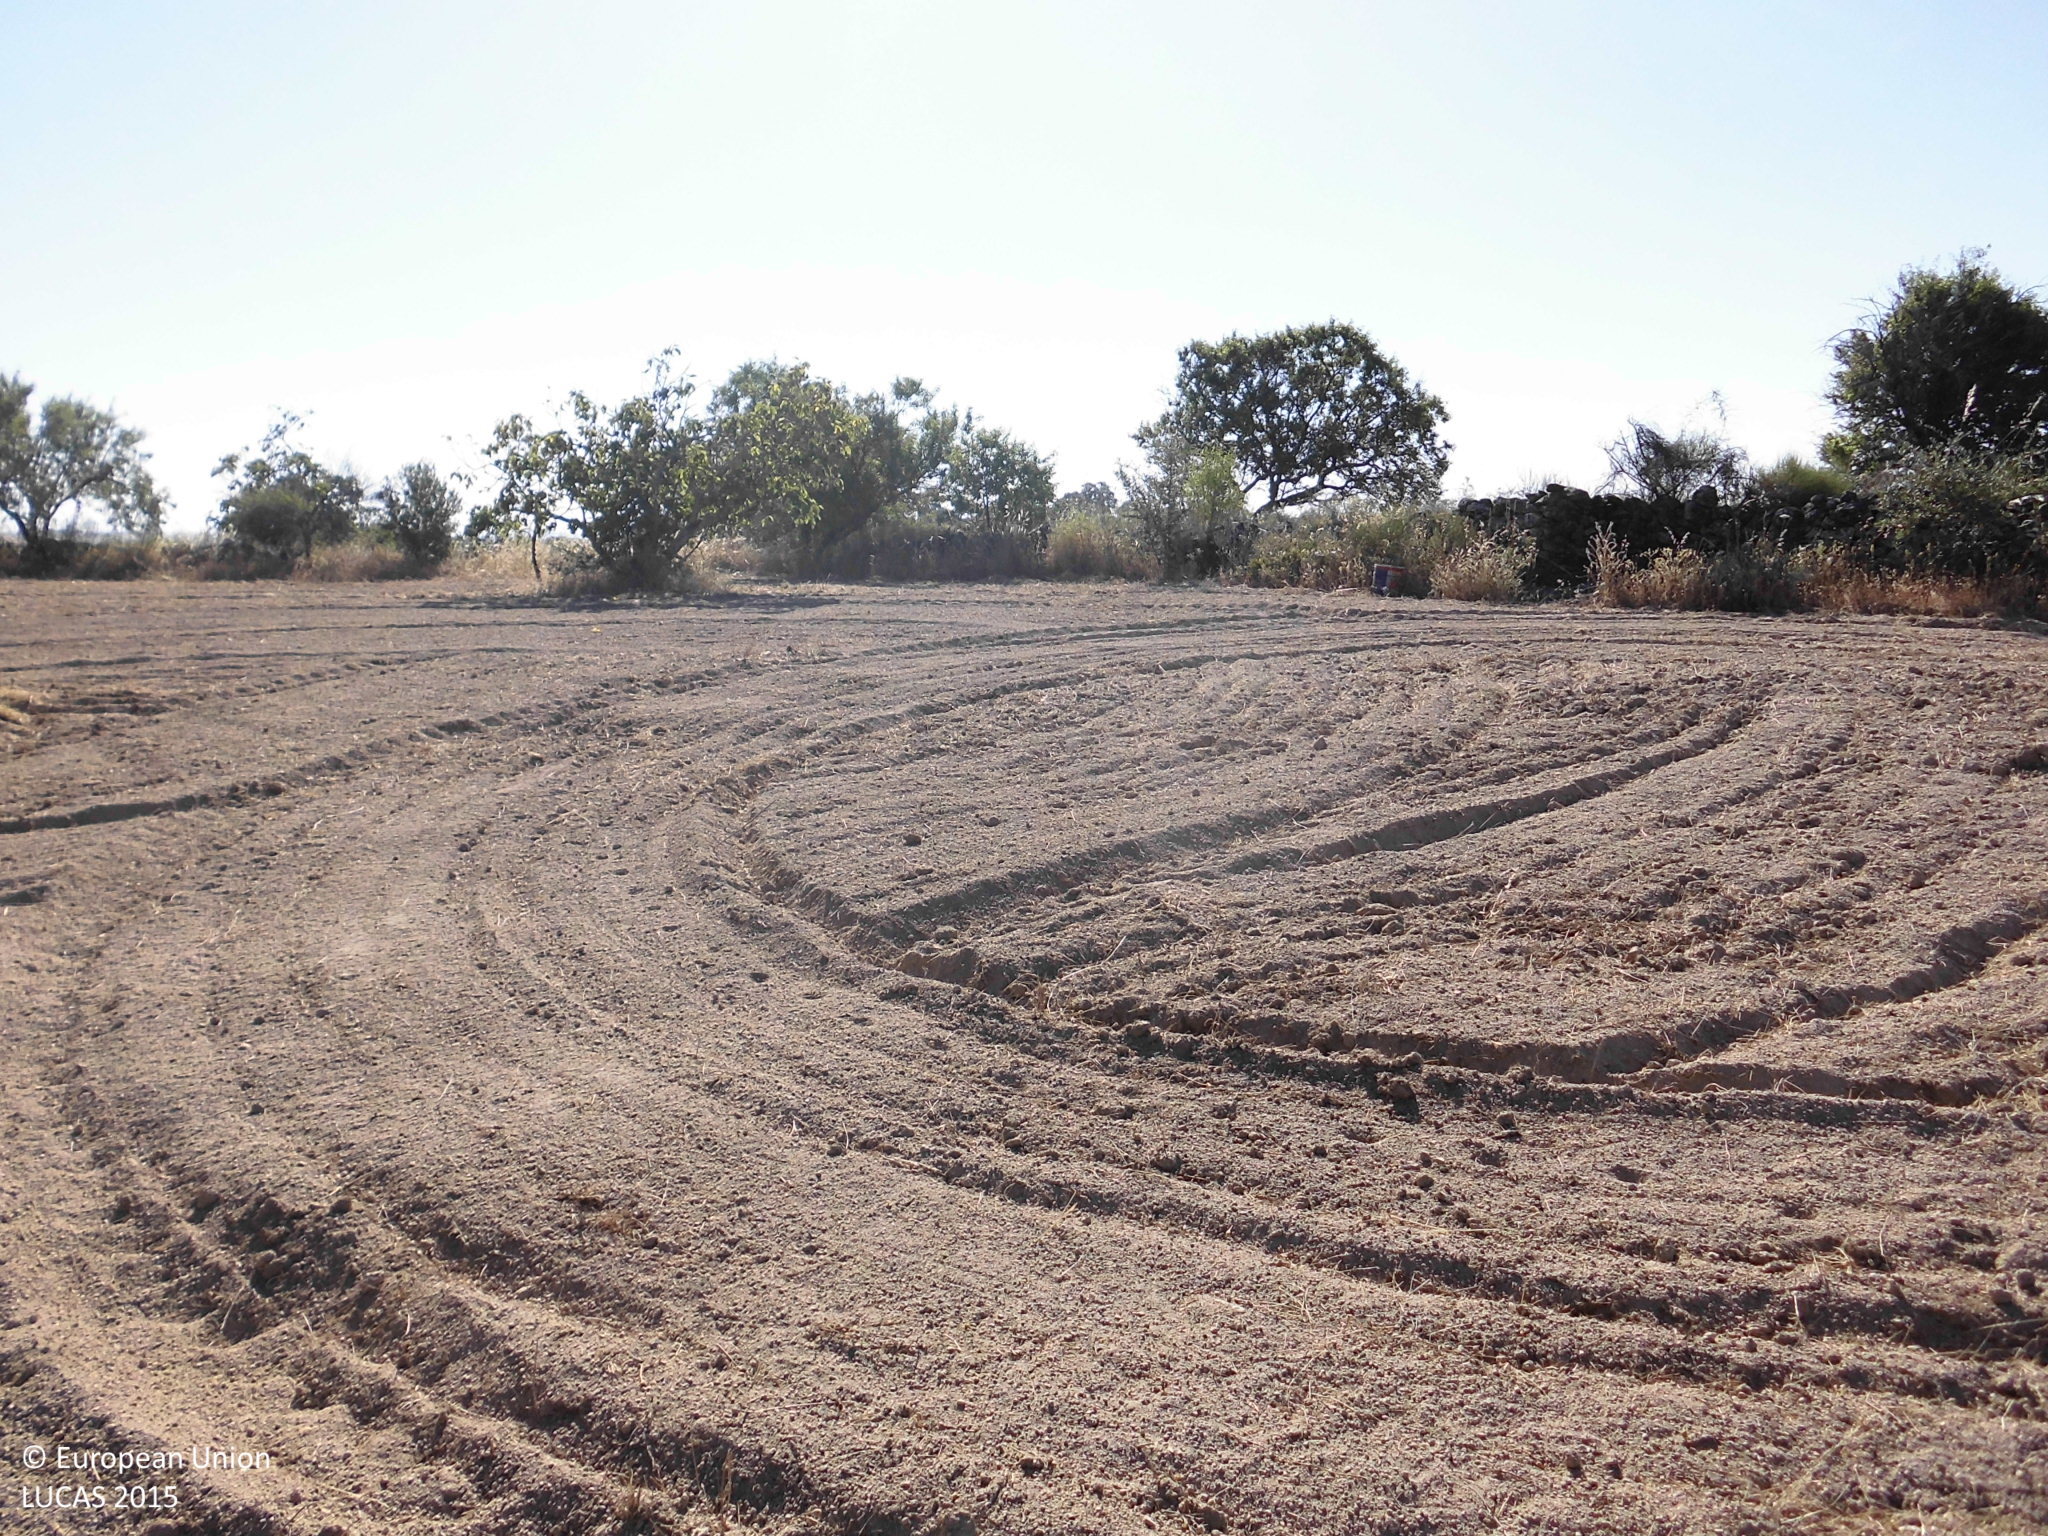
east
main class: Cropland
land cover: Other fruit trees and berries
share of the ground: 10 - 25 %
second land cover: Other bare soil
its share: > 75 %
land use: Agriculture (excluding fallow land and kitchen gardens)
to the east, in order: Other fruit trees and berries; Other bare soil; Grass margins; Olive groves; Dry stone walls; Grassland with sparse tree/shrub cover; Shruby margins; Other fresh vegetables; Groves; Other fresh vegetables; Vineyards; Grassland with sparse tree/shrub cover; Olive groves; Nuts trees
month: May
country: ES
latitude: 39.8109
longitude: -6.7506
